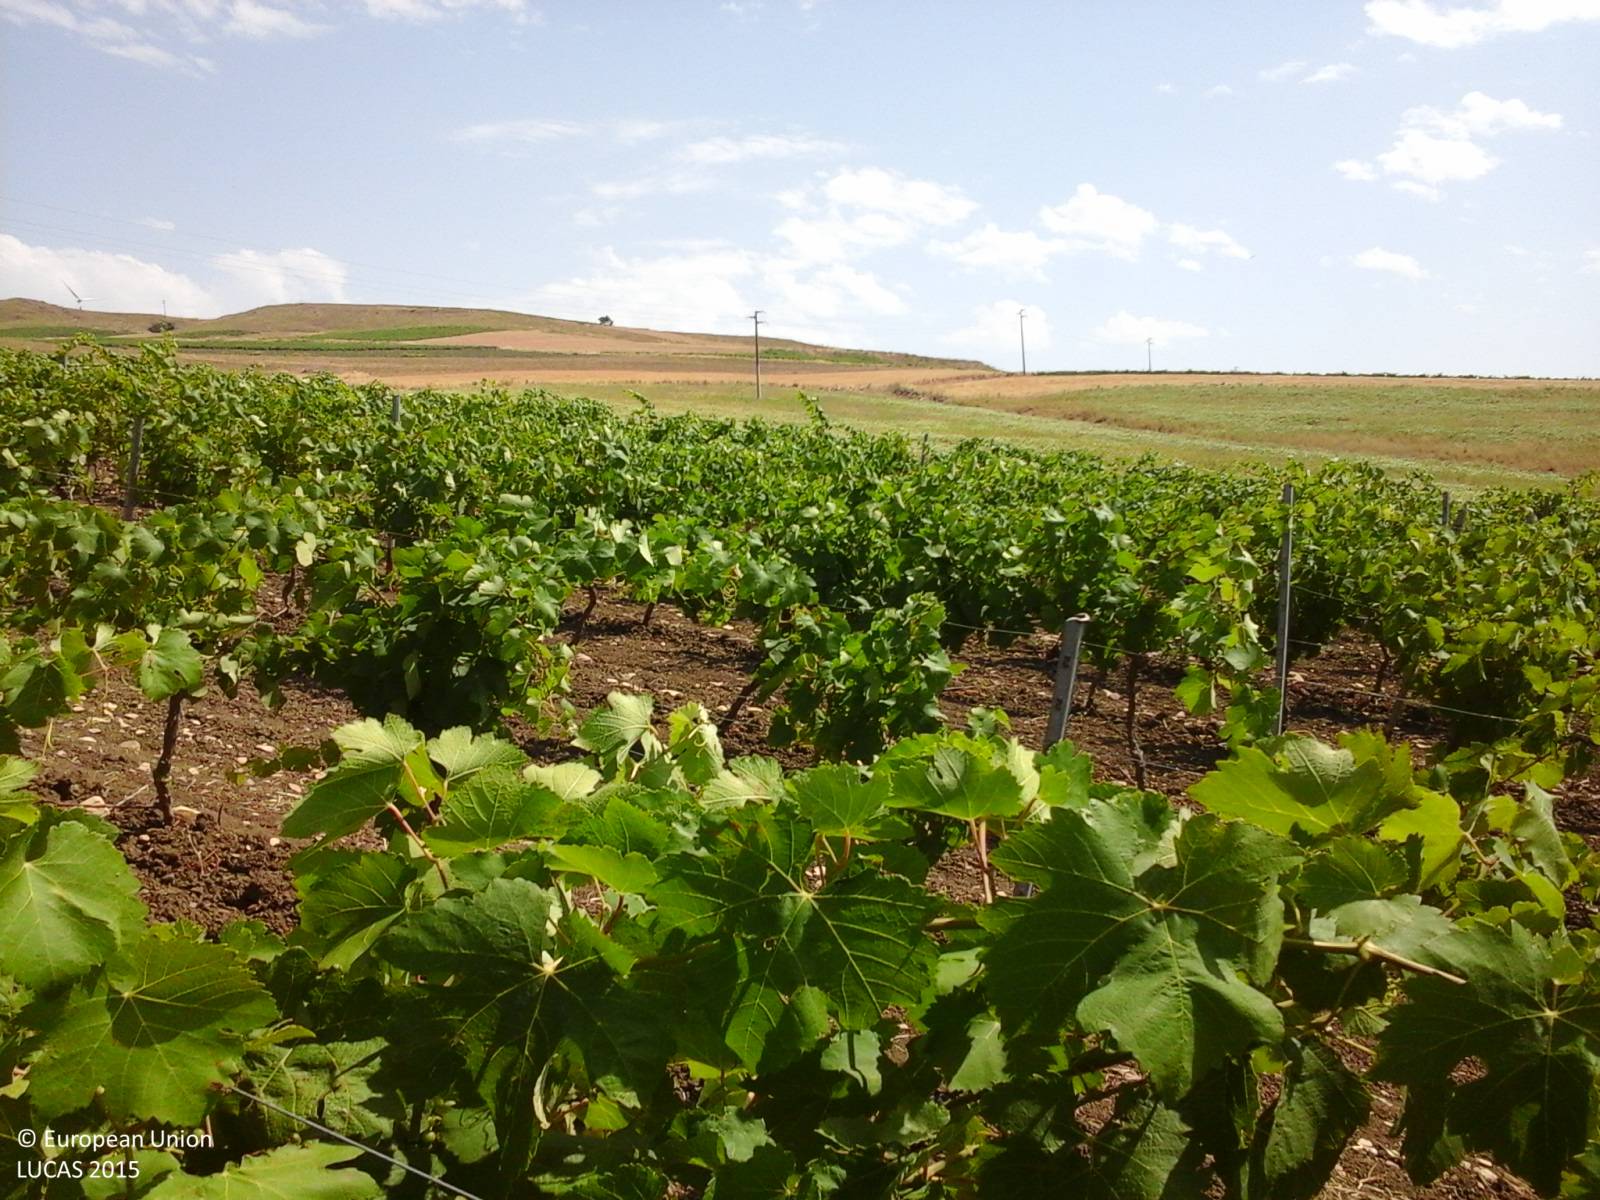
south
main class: Cropland
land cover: Vineyards
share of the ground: 50 - 75 %
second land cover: Other bare soil
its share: > 75 %
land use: Agriculture (excluding fallow land and kitchen gardens)
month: June
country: IT
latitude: 37.8734
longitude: 12.6746
